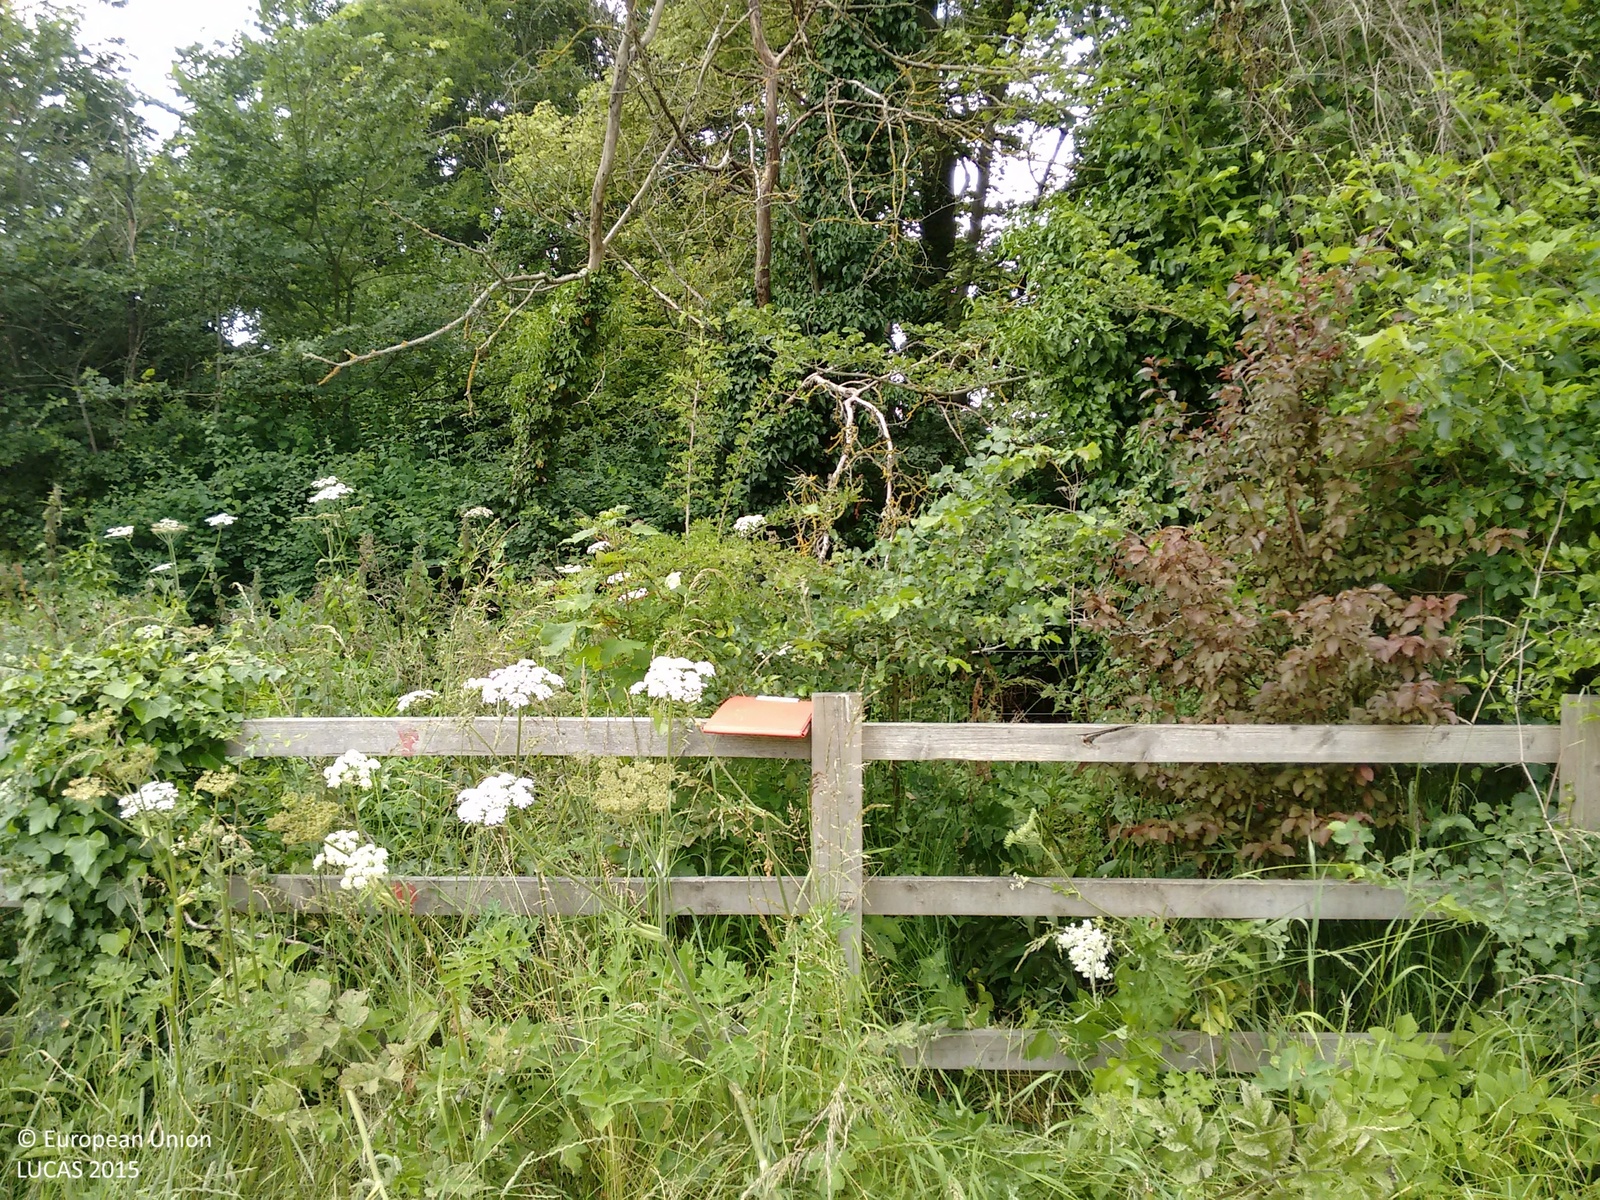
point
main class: Woodland
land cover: Broadleaved woodland
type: mesophytic deciduous forest
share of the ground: > 75 %
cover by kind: broadleaved forest trees 60 %, herbaceous plants 40 %
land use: Semi-natural and natural areas not in use
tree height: > 5 m
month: June
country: GB
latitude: 51.6386
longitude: -1.2753
